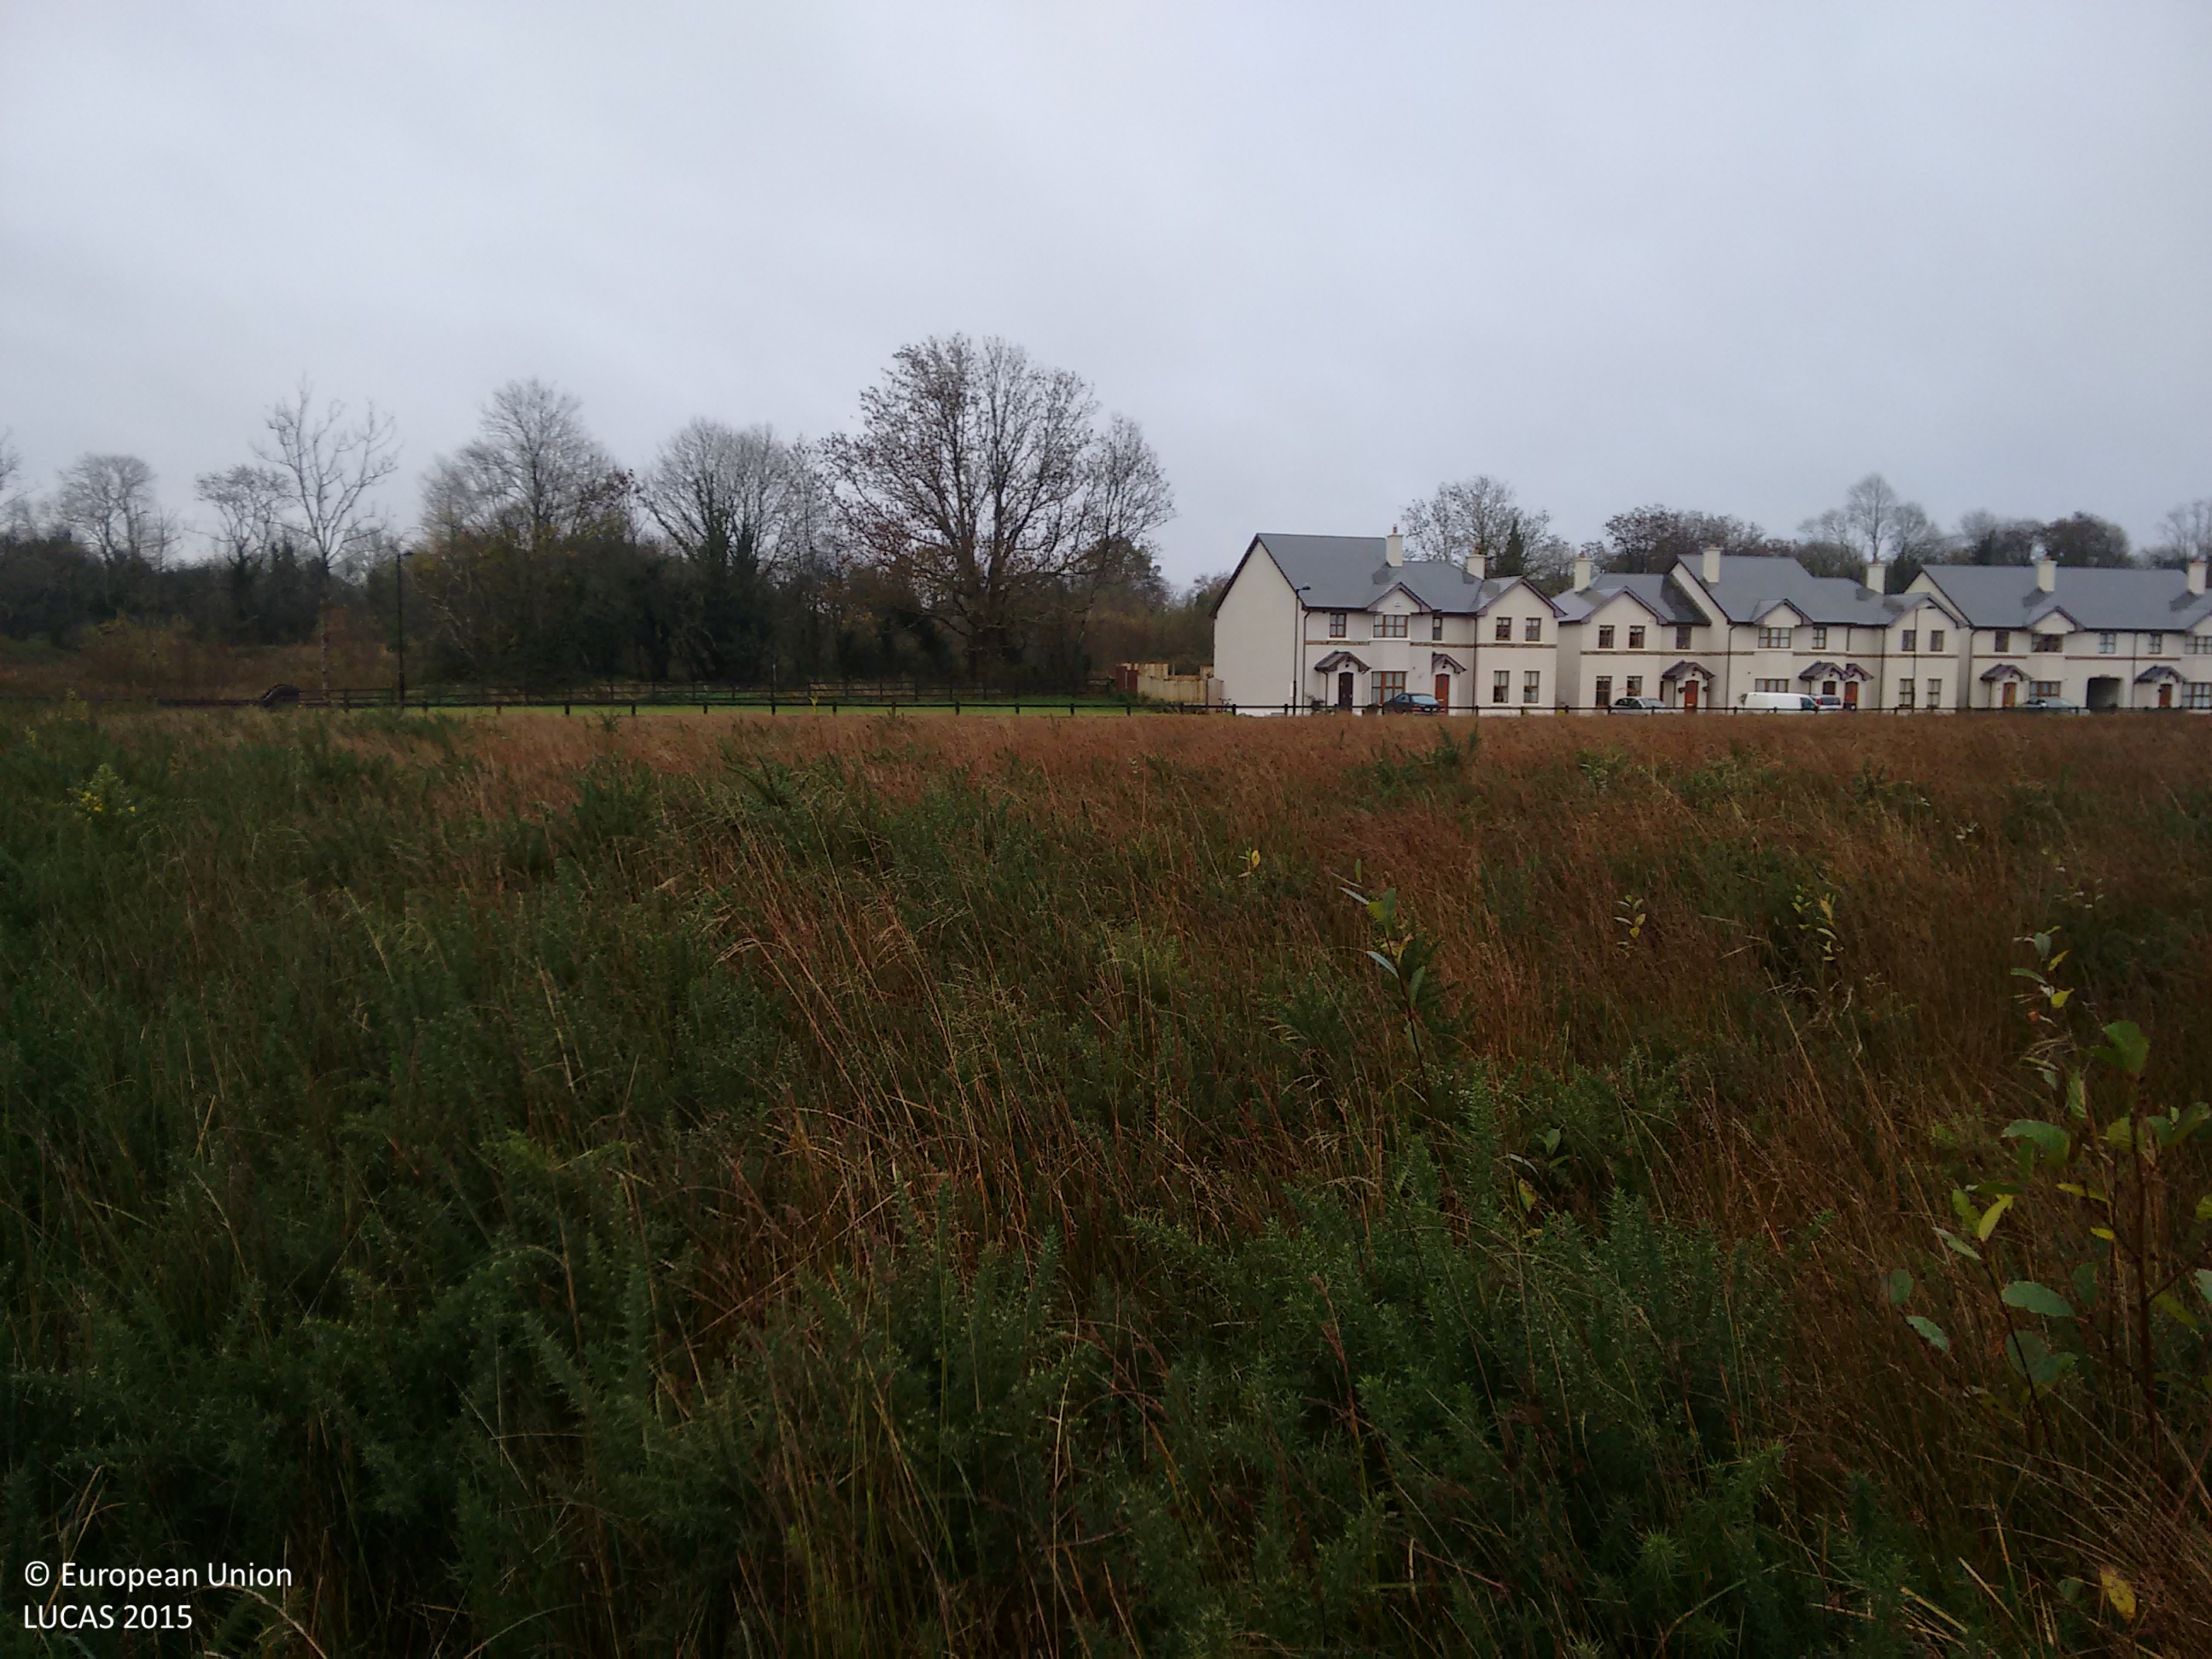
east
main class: Grassland
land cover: Spontaneously vegetated surfaces
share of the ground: > 75 %
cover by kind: herbaceous plants 95 %, shrubs 5 %
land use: Abandoned areas
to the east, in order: Spontaneously vegetated surfaces; Fences; Grass margins; Paved roads, cycling and walking lanes; Tracks; Grassland without tree/shrub cover; Fences; Spontaneously vegetated surfaces; Broadleaved woodland; Electric lines; Broadleaved woodland; Grass margins; Paved roads, cycling and walking lanes; Grass margins; Broadleaved woodland; Ditches and canals; Broadleaved woodland; Spontaneously vegetated surfaces
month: November
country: IE
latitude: 53.8579
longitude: -7.9144
